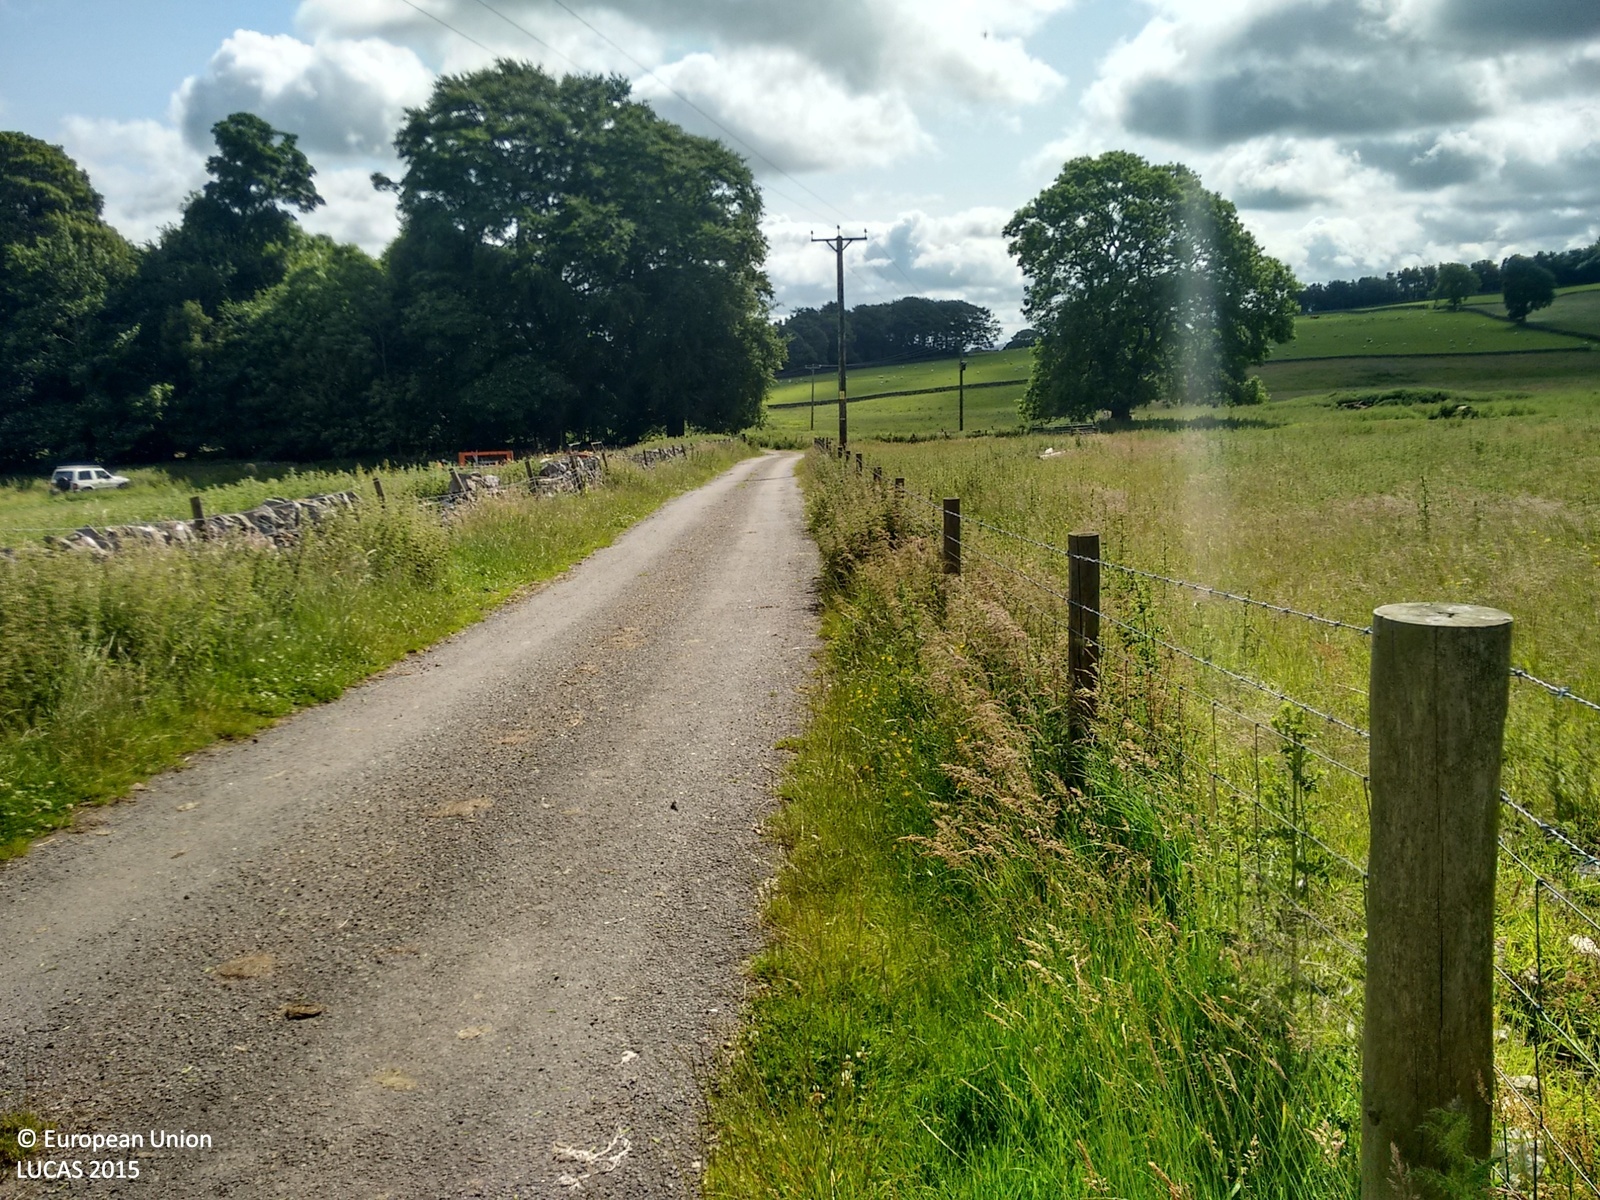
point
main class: Grassland
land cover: Grassland with sparse tree/shrub cover
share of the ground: > 75 %
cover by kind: herbaceous plants 85 %, shrubs 10 %, broadleaved forest trees 5 %
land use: Agriculture (excluding fallow land and kitchen gardens)
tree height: > 5 m
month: July
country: GB
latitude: 53.1564
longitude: -1.7334
